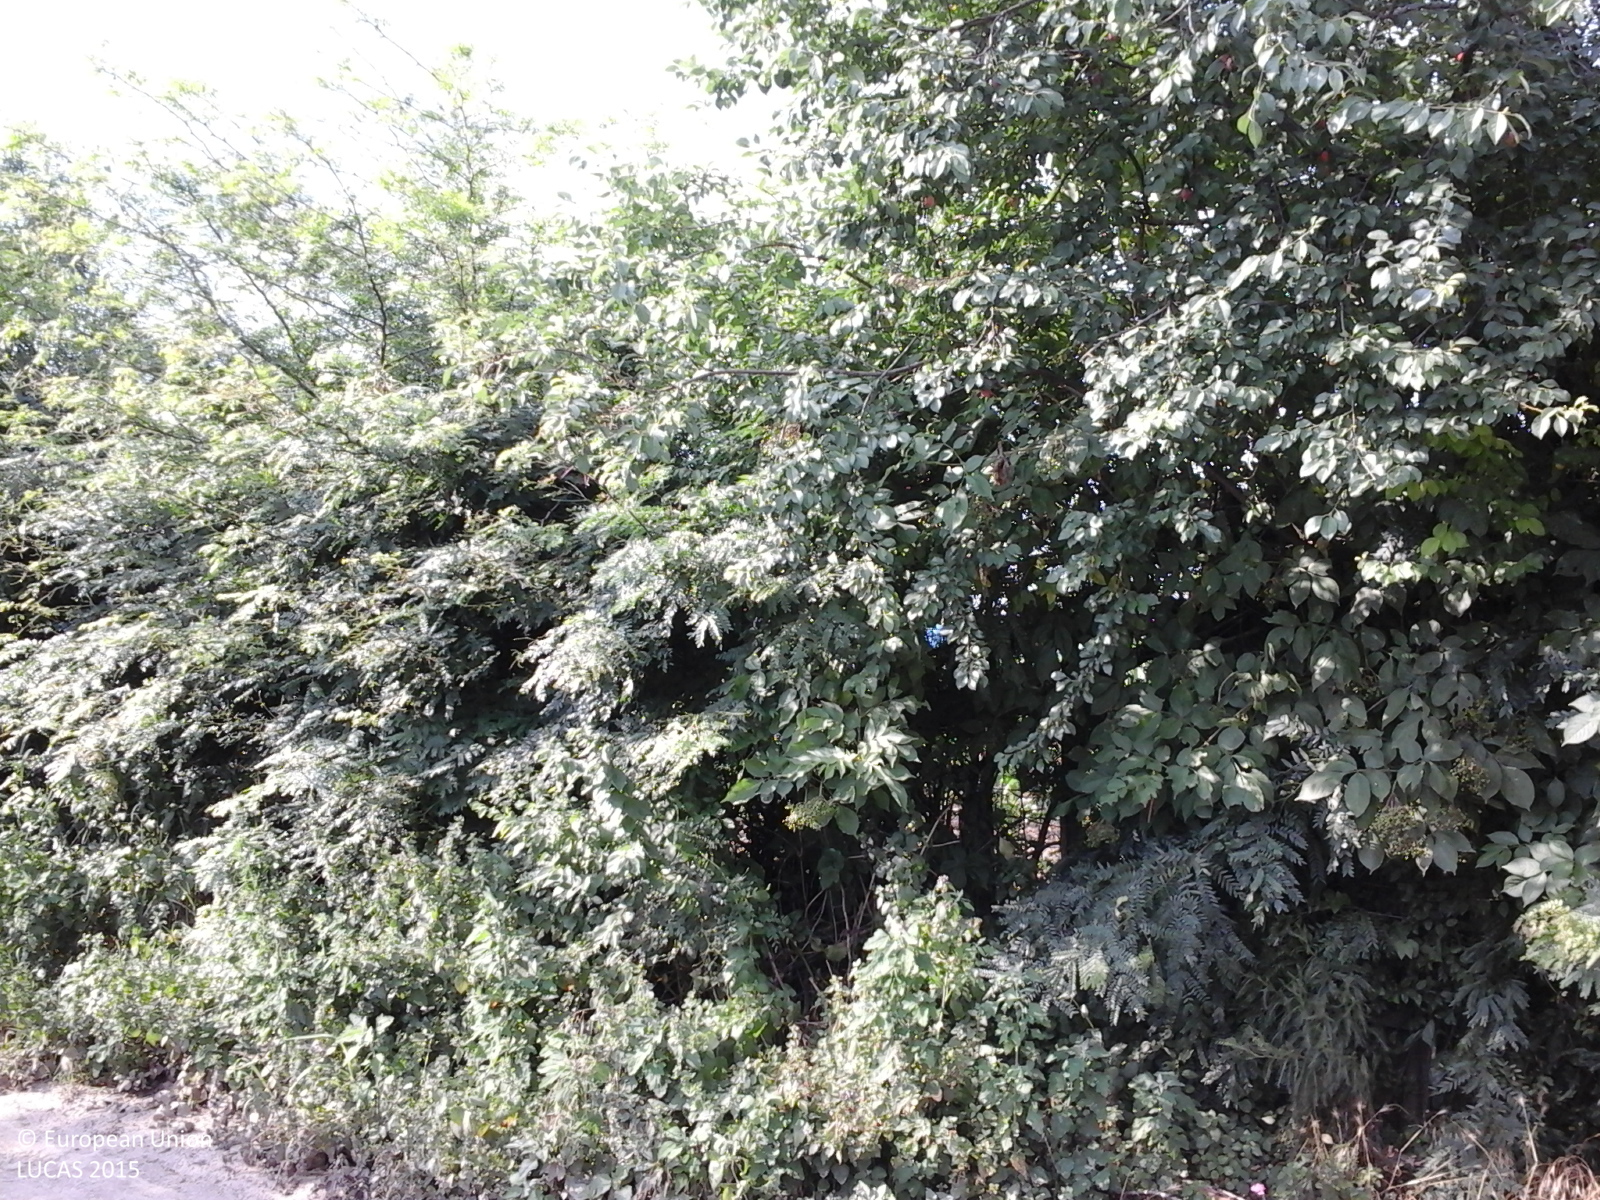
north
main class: Cropland
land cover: Maize
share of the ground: > 75 %
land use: Agriculture (excluding fallow land and kitchen gardens)
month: June
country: RO
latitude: 44.3116
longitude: 26.1134
